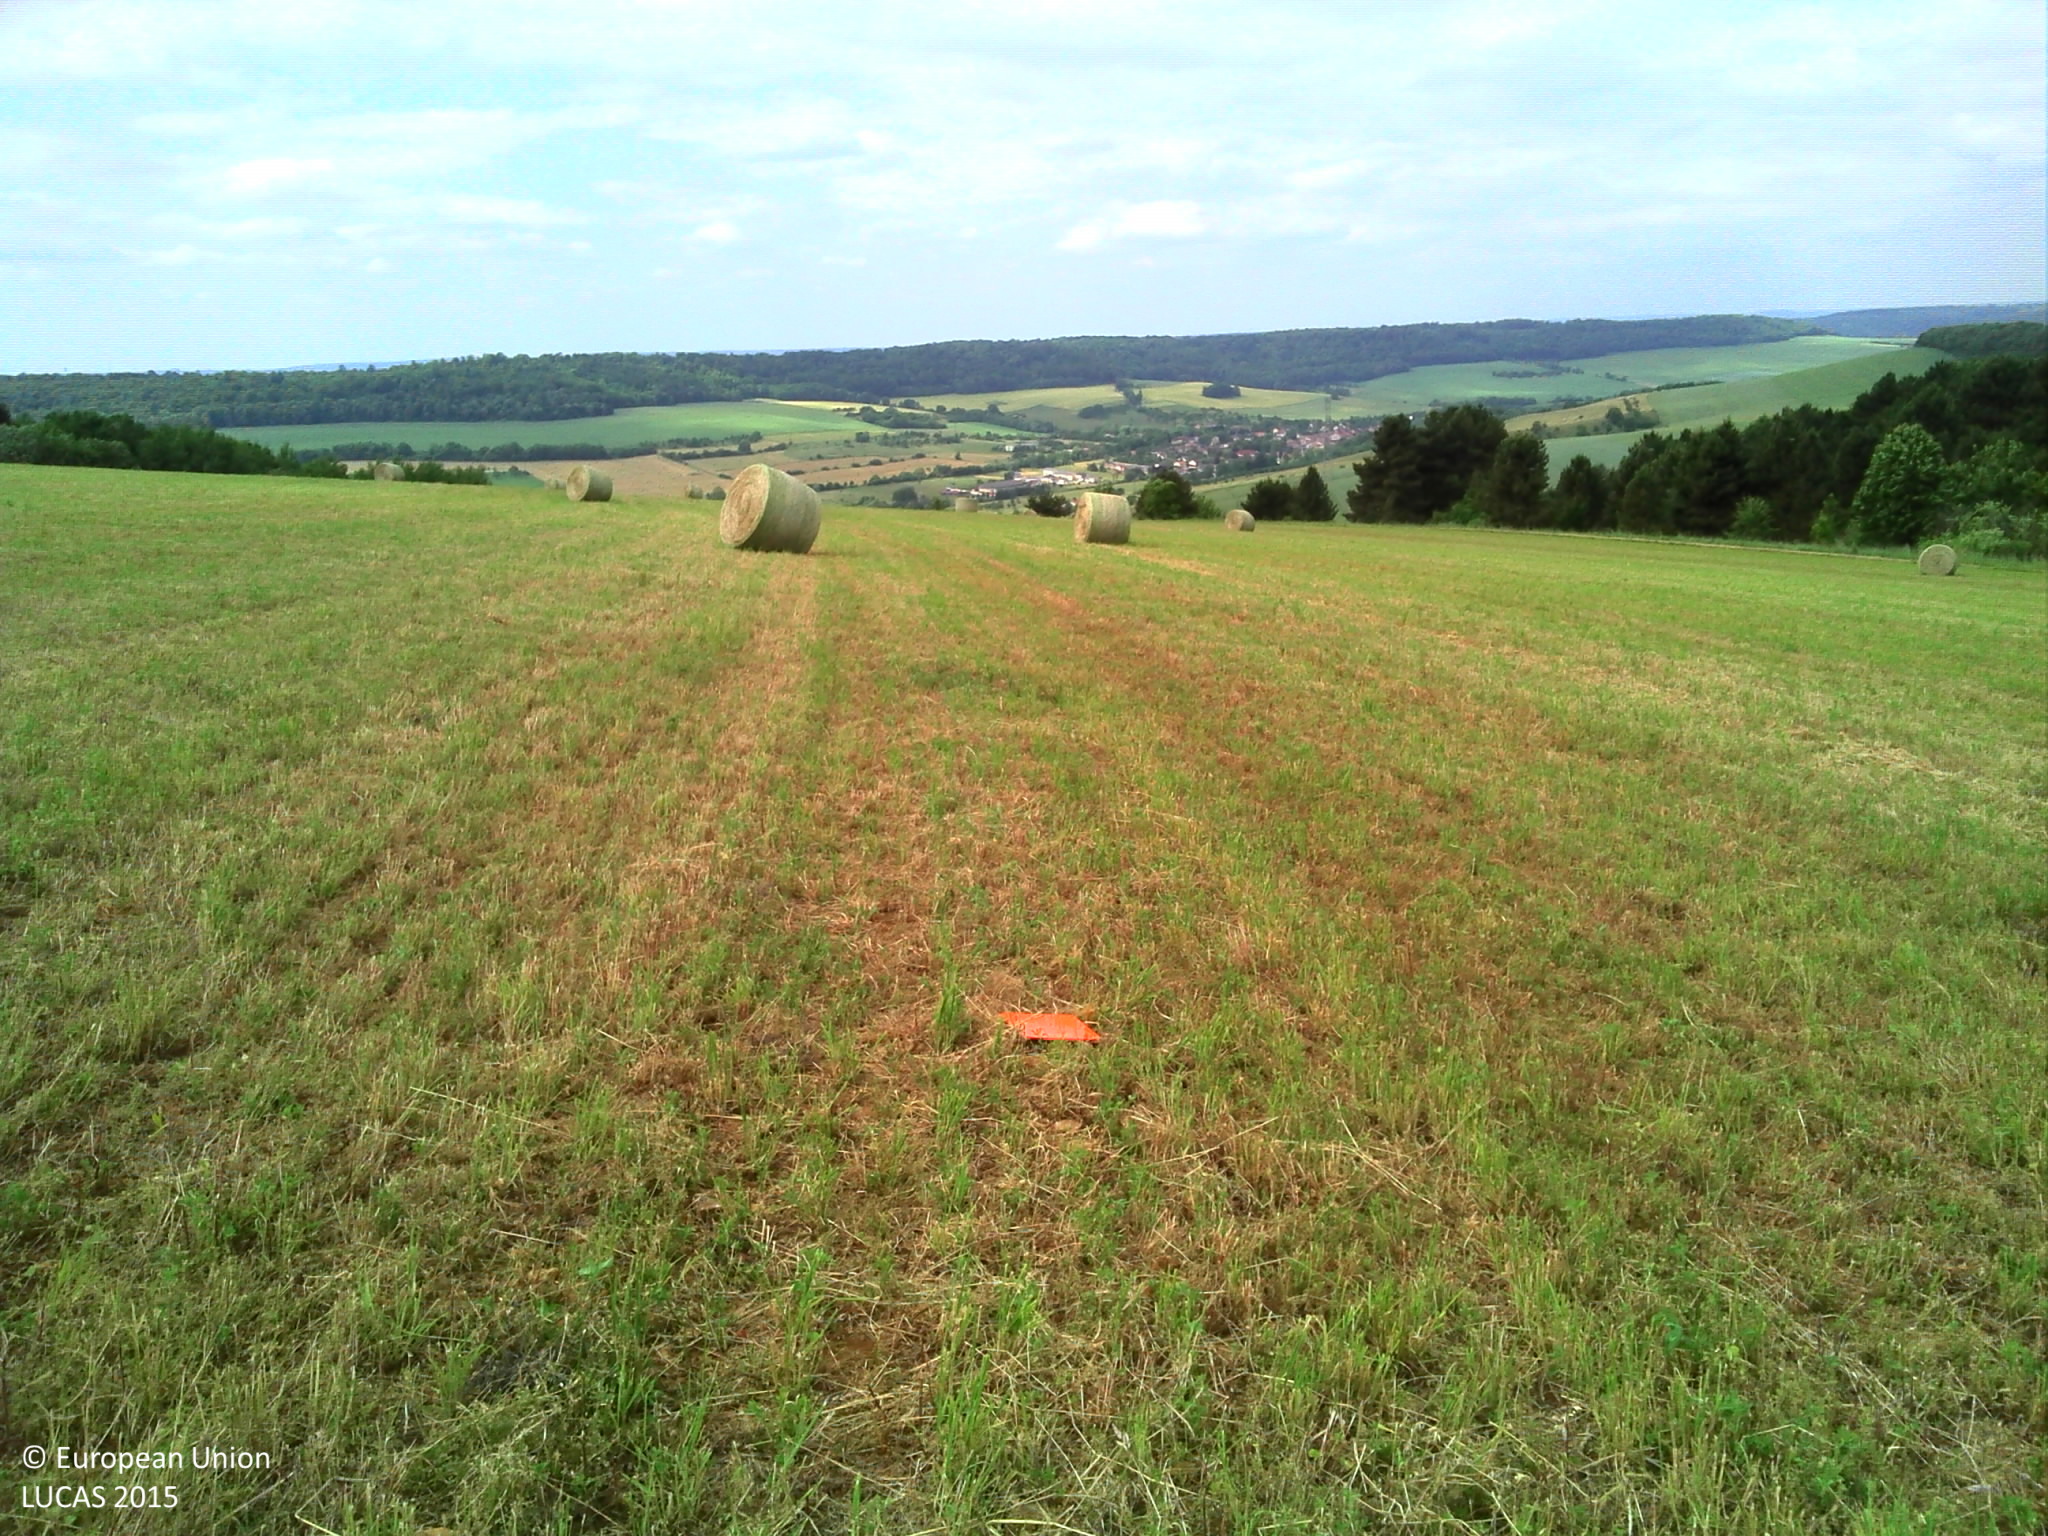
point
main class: Cropland
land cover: Temporary grasslands
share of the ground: > 75 %
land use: Agriculture (excluding fallow land and kitchen gardens)
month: June
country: FR
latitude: 48.8075
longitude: 6.2282
